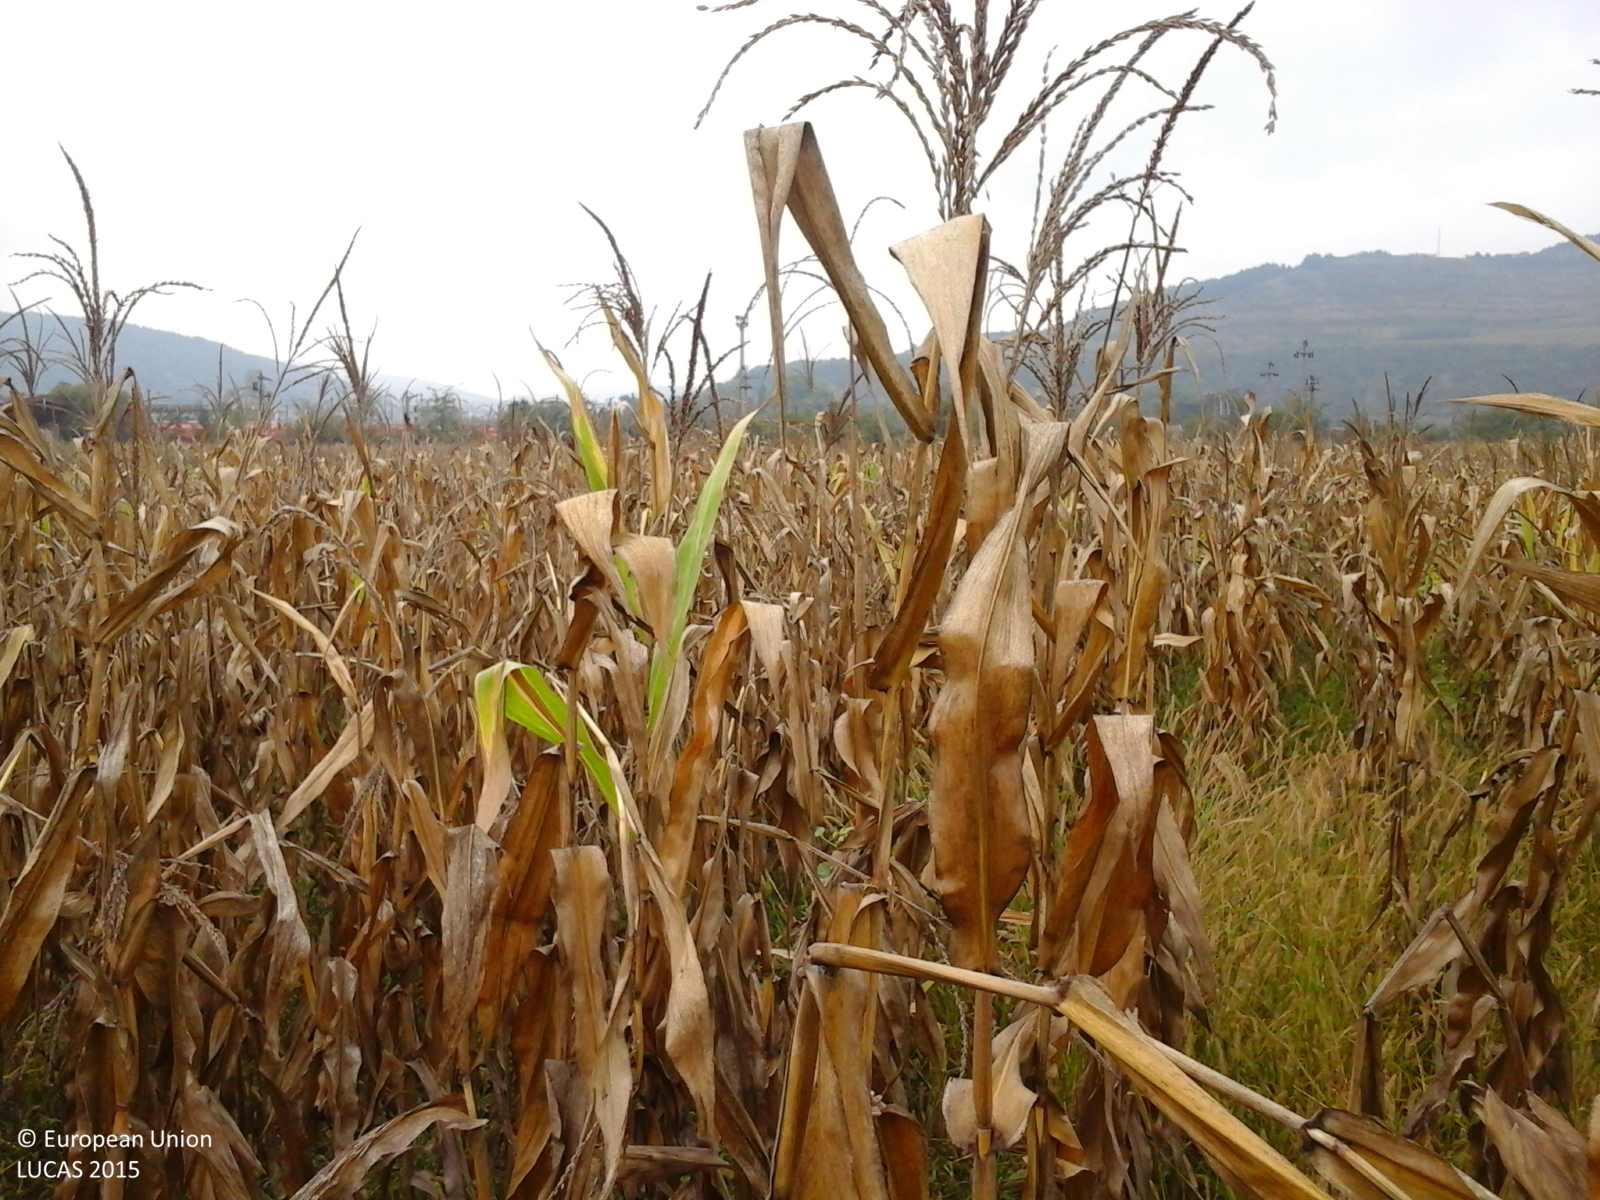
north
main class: Cropland
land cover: Maize
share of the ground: > 75 %
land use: Agriculture (excluding fallow land and kitchen gardens)
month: September
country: RO
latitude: 45.9179
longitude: 22.8565
